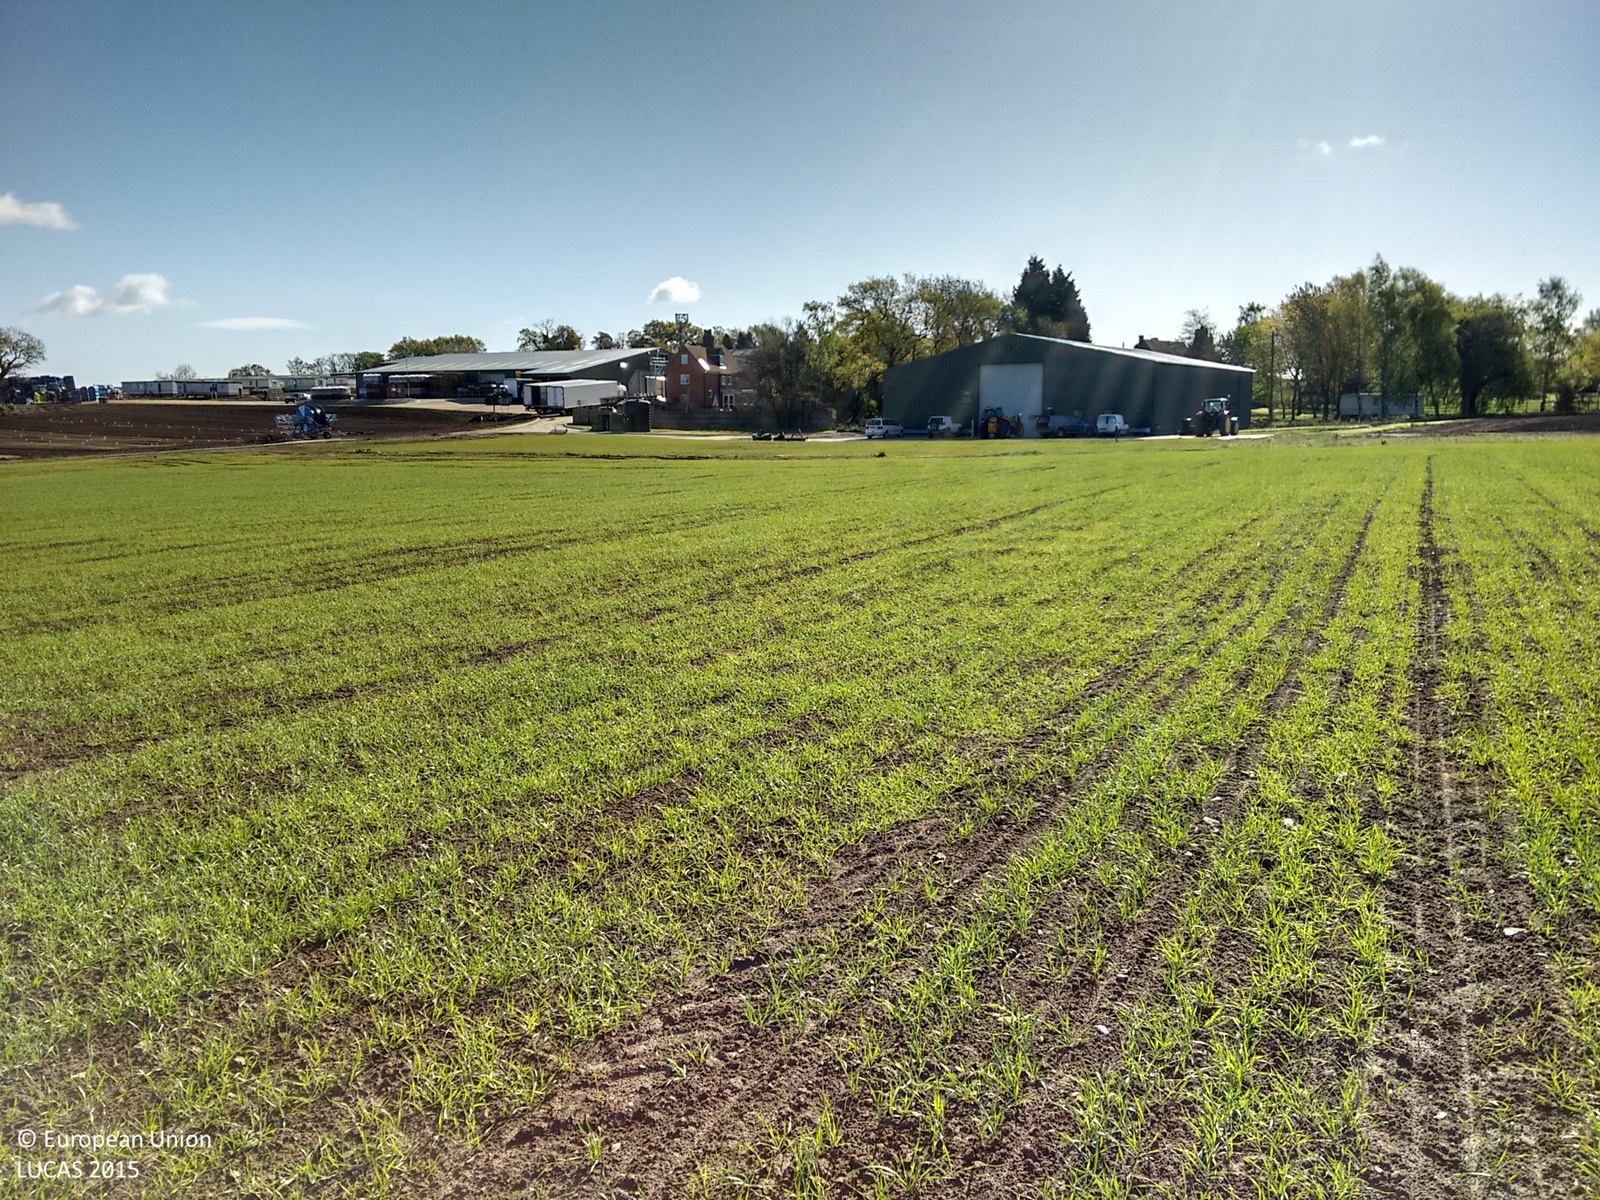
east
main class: Cropland
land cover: Common wheat
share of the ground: 25 - 50 %
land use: Agriculture (excluding fallow land and kitchen gardens)
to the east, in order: Common wheat; Grassland without tree/shrub cover; Artificial constructions in urban areas
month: April
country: GB
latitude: 51.2975
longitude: 0.3762
